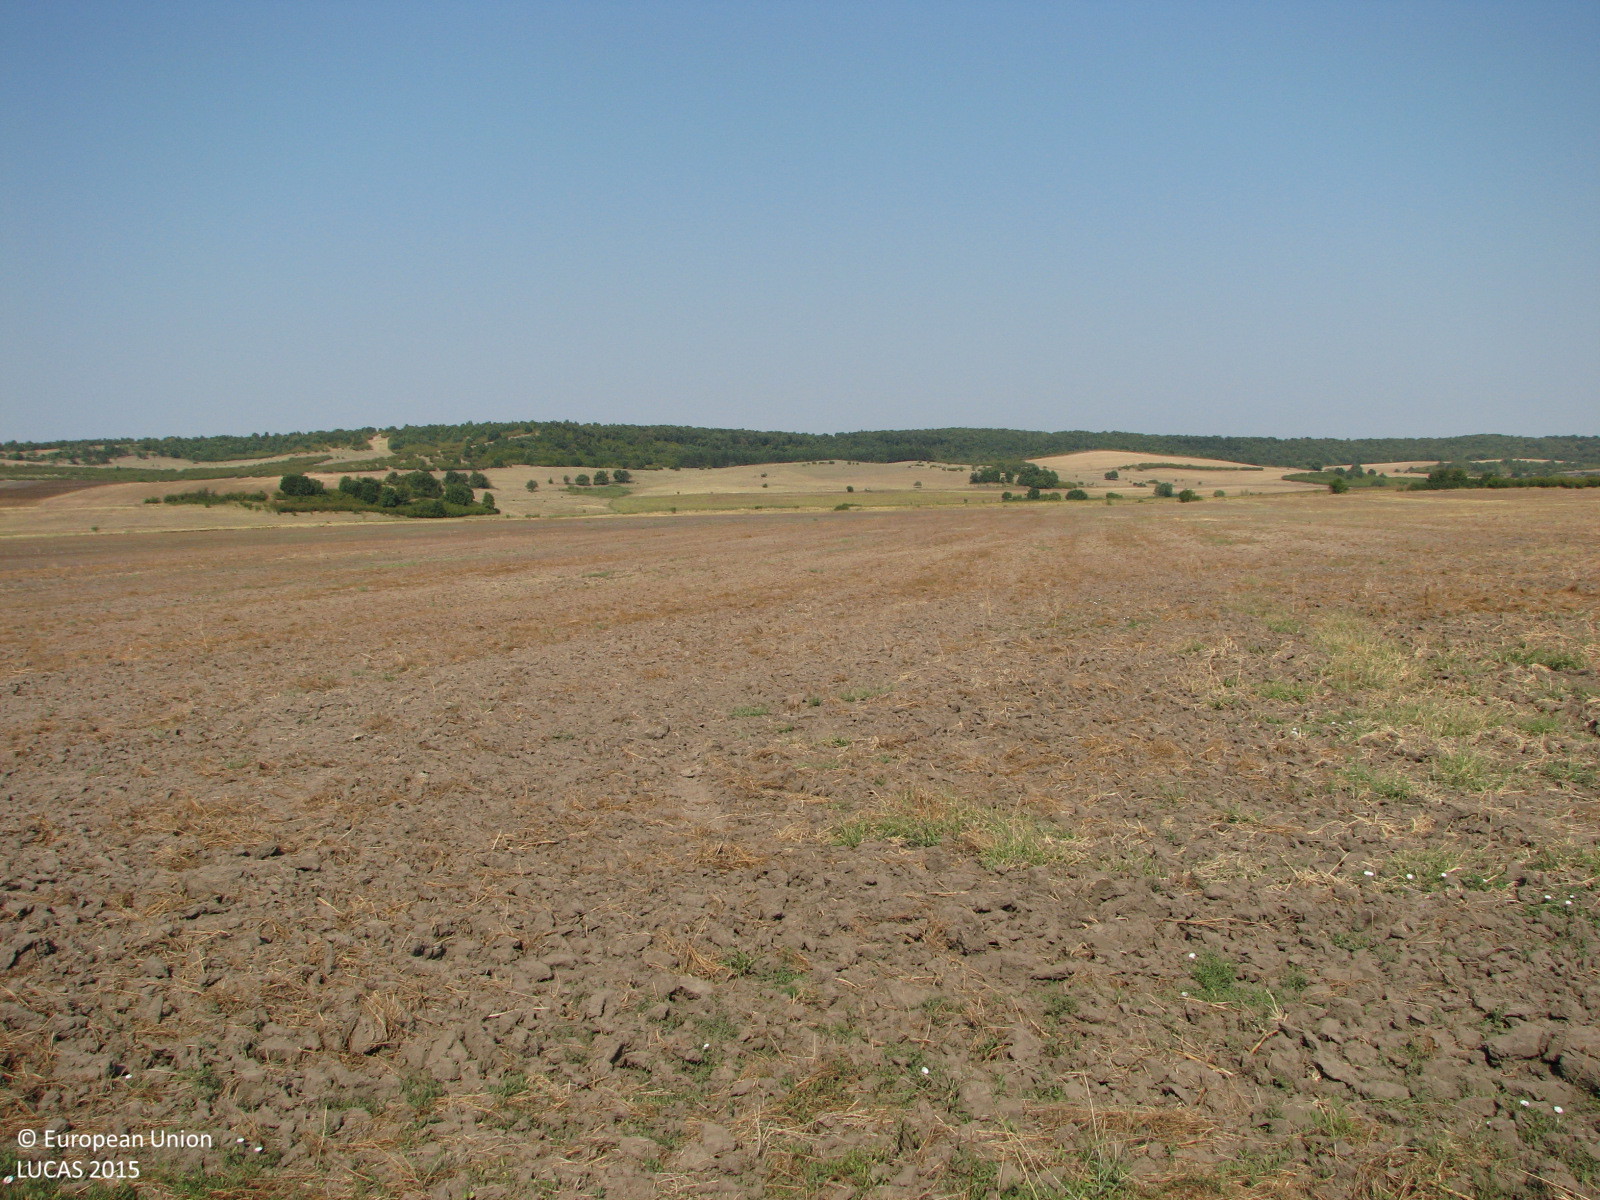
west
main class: Grassland
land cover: Spontaneously vegetated surfaces
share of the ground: > 75 %
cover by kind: herbaceous plants 100 %
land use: Semi-natural and natural areas not in use
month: August
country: BG
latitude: 42.1839
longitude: 26.5436
